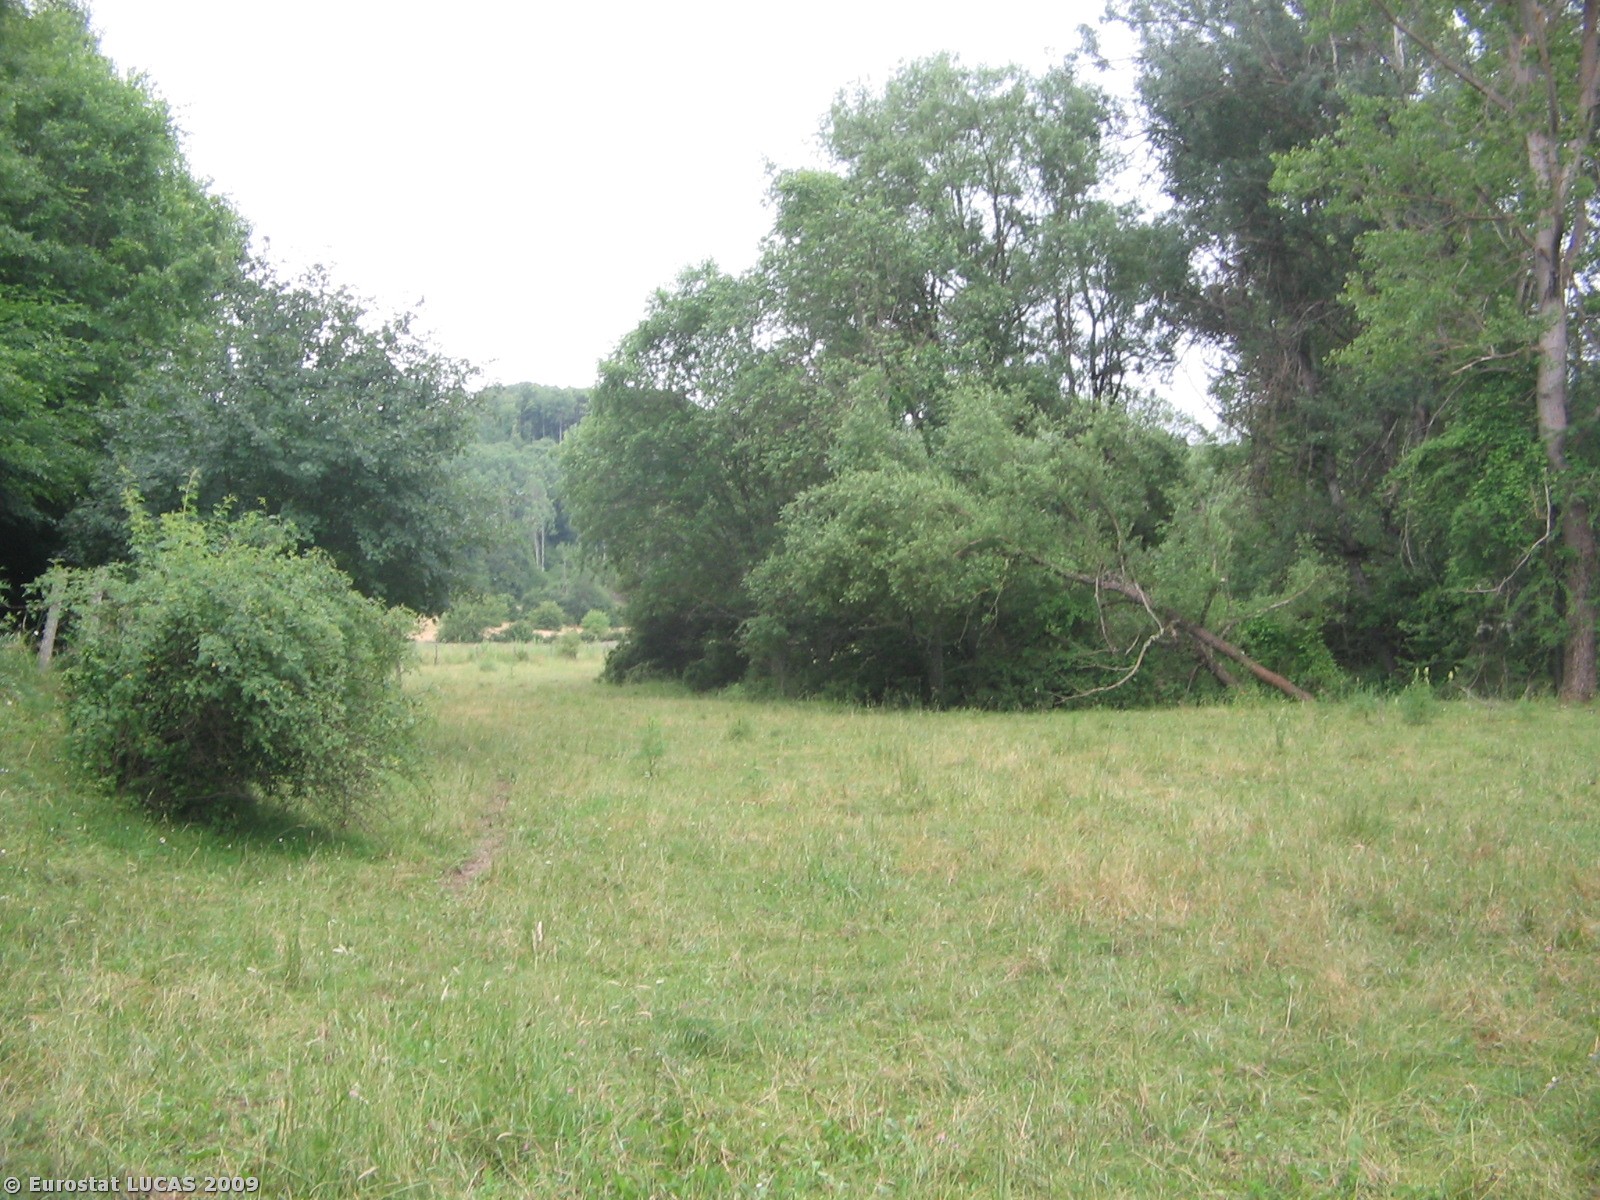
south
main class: Grassland
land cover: Grassland without tree/shrub cover
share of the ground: > 75 %
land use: Agriculture (excluding fallow land and kitchen gardens)
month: June
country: IT
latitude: 42.6021
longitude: 13.2443
